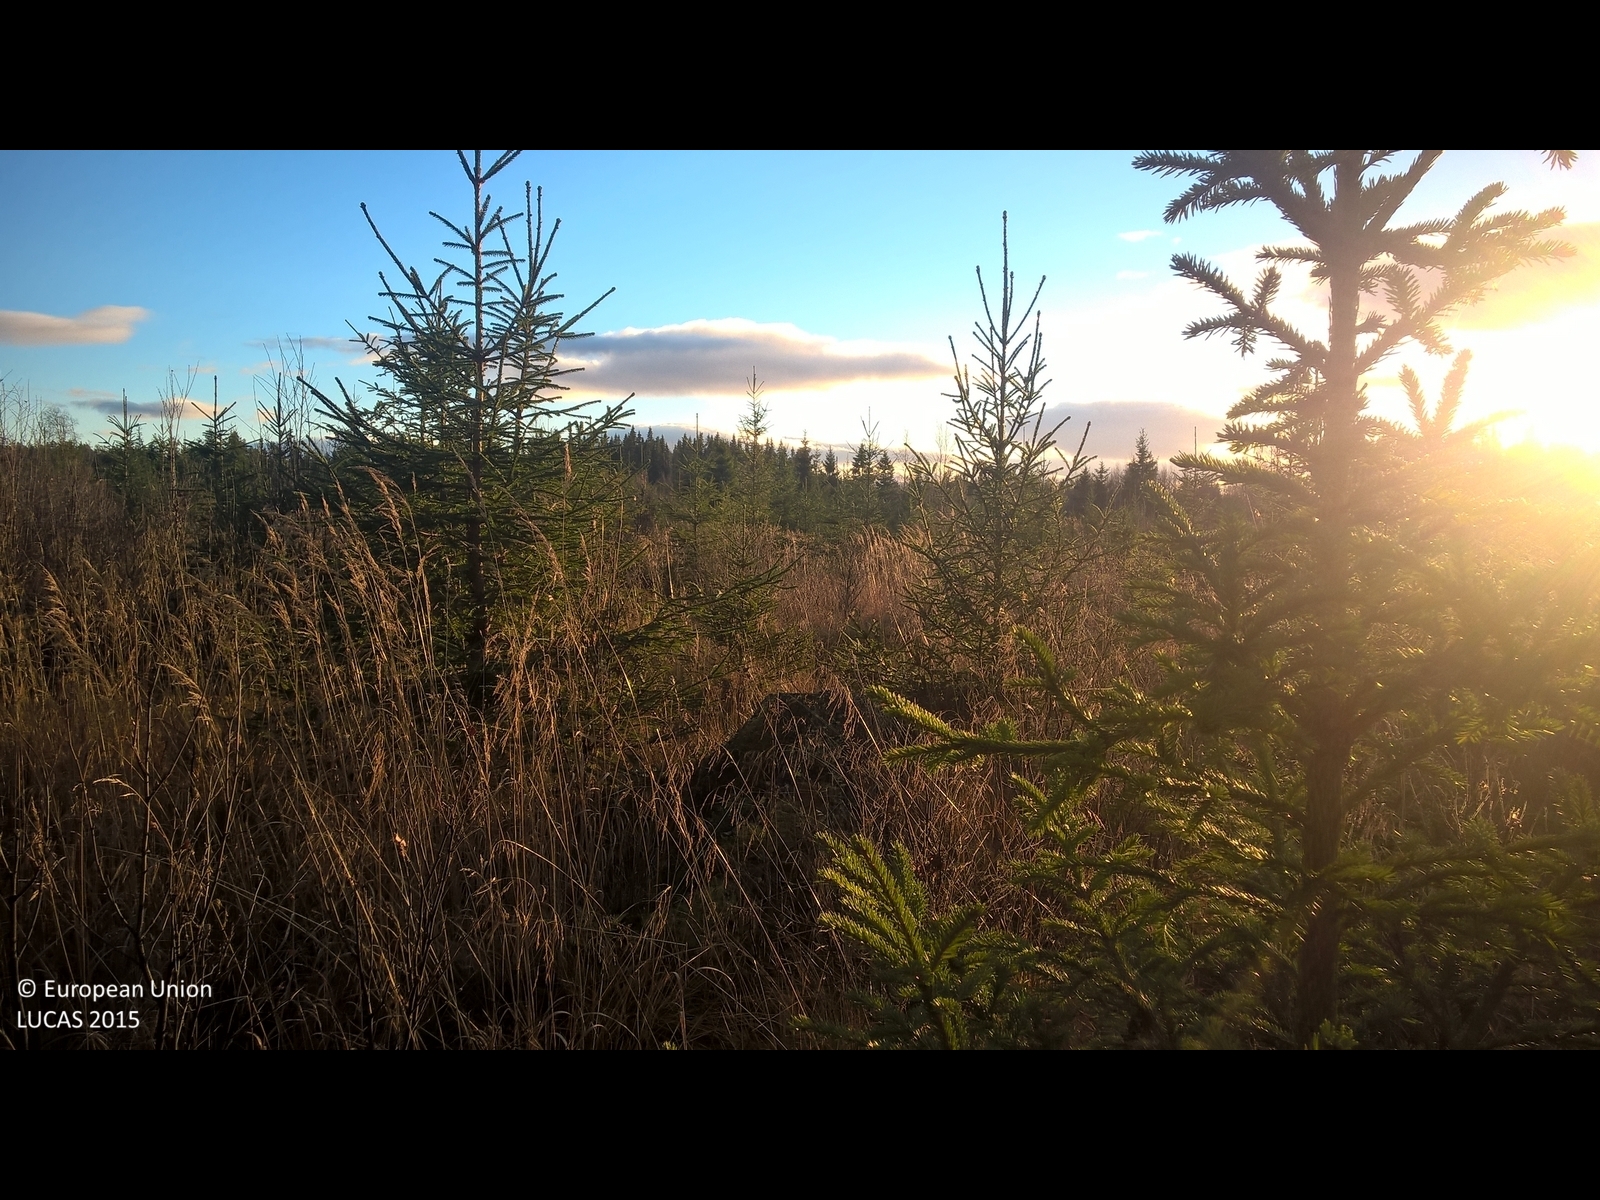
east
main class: Woodland
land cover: Spruce dominated coniferous woodland
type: boreal forest
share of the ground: 25 - 50 %
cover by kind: herbaceous plants 70 %, coniferous forest trees 20 %, broadleaved forest trees 5 %, shrubs 5 %
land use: Forestry
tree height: < 5 m
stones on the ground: < 10 %
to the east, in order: Spruce dominated coniferous woodland; Ditches and canals; Spruce dominated coniferous woodland
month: November
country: SE
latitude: 63.0326
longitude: 14.5060
